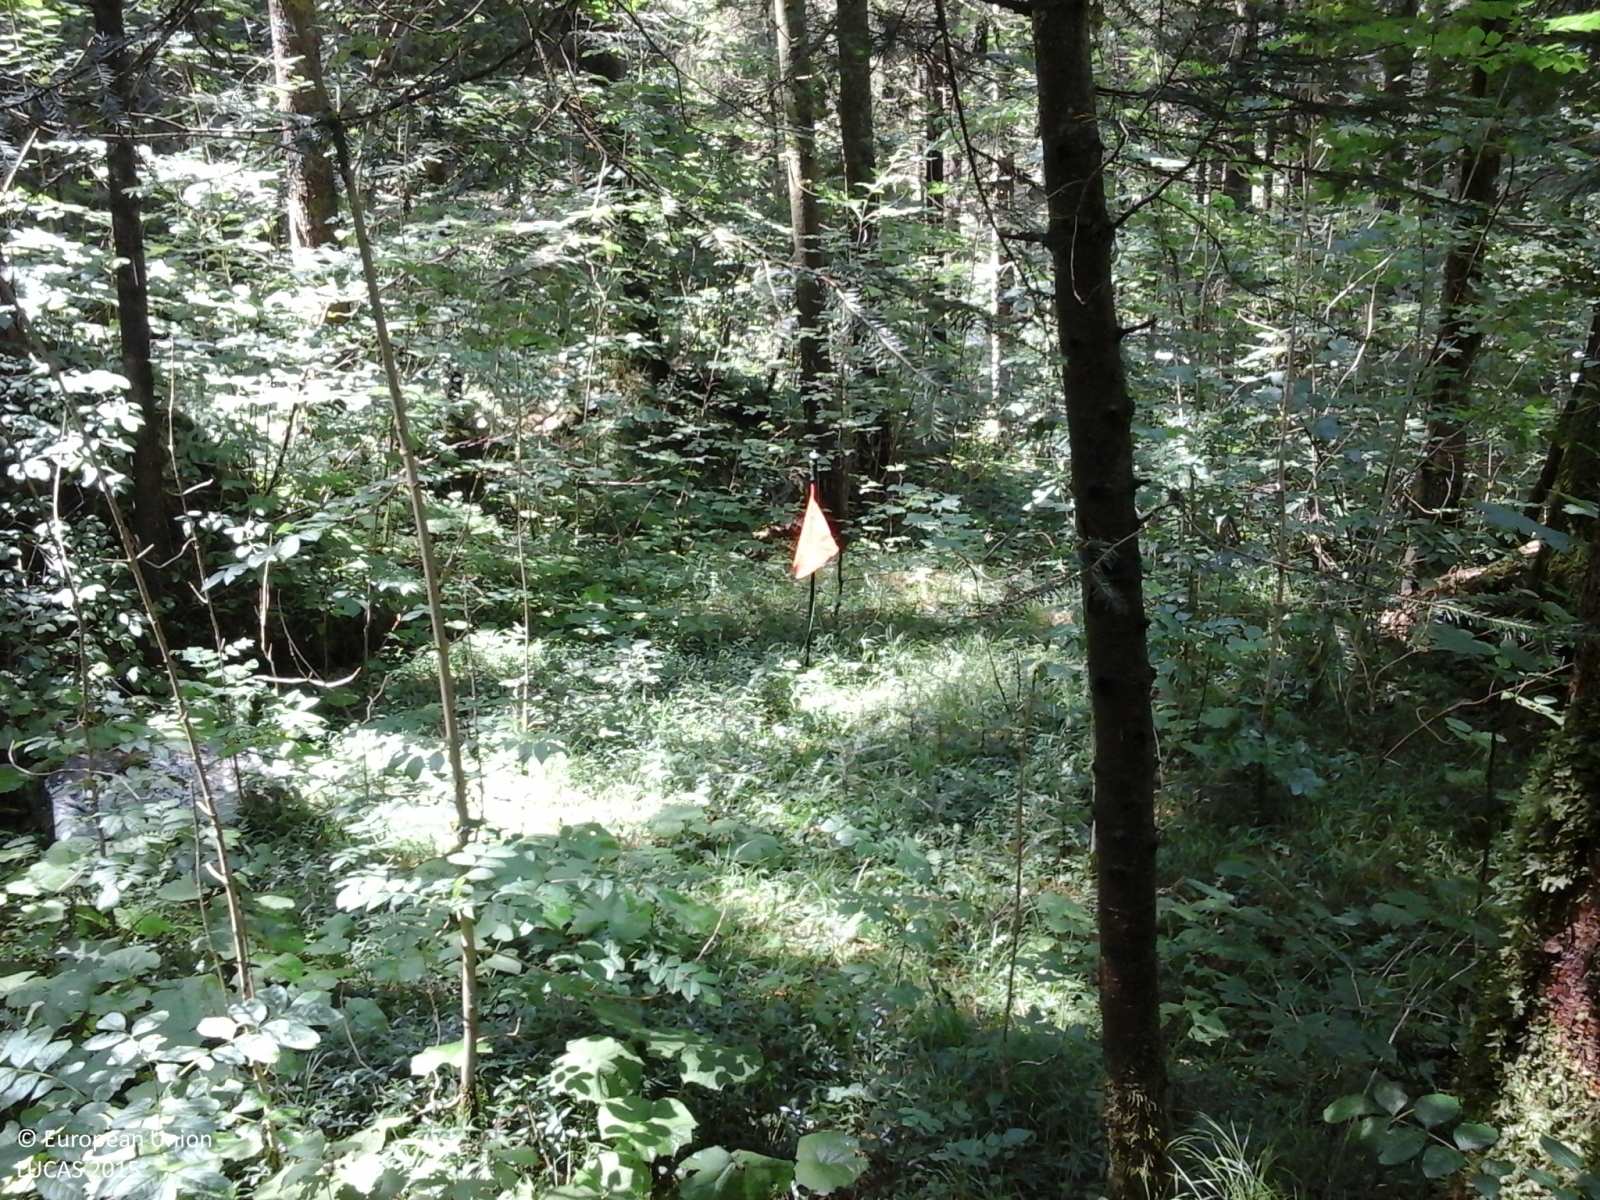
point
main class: Woodland
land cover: Spruce dominated mixed woodland
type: alpine coniferous forest
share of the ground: > 75 %
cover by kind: coniferous forest trees 75 %, broadleaved forest trees 25 %
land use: Semi-natural and natural areas not in use
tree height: > 5 m
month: July
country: IT
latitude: 45.9728
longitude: 10.1160
